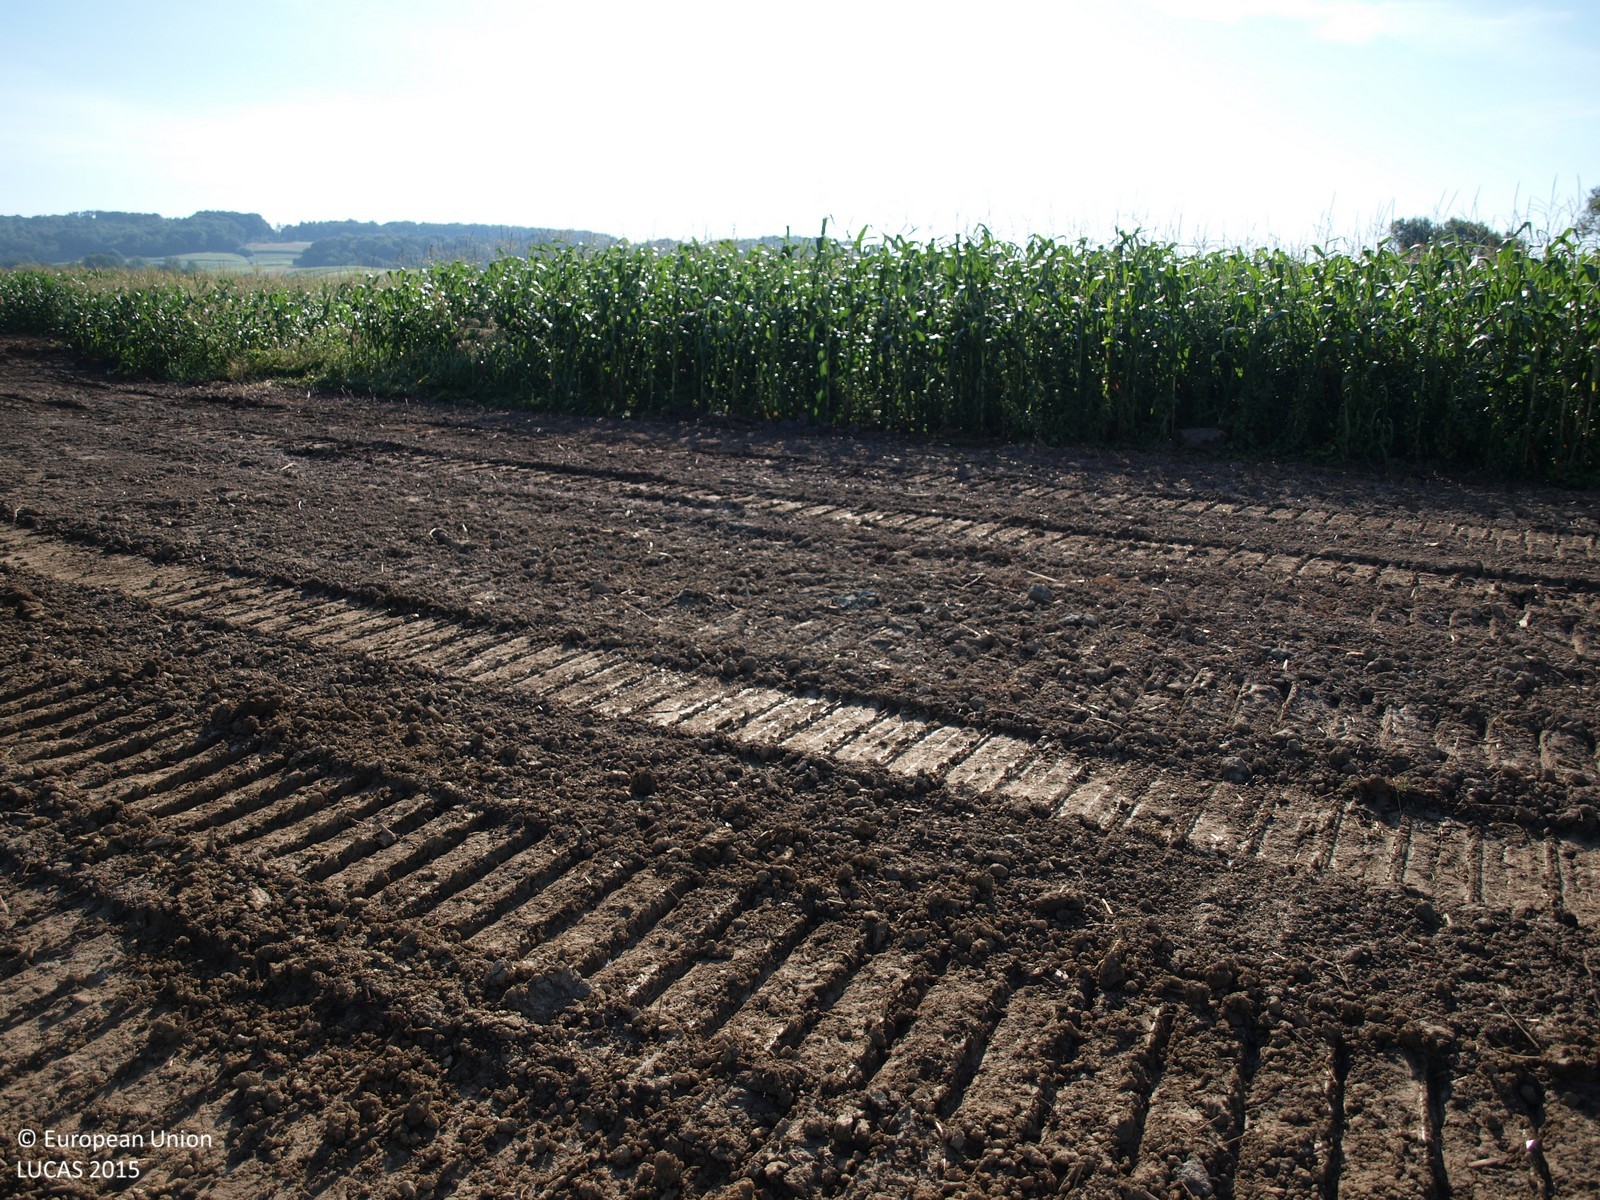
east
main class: Shrubland
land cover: Shrubland with sparse tree cover
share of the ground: > 75 %
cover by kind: shrubs 95 %, broadleaved forest trees 5 %
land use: Semi-natural and natural areas not in use
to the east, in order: Shrubland with sparse tree cover; Rivers and streams; Other bare soil; Maize; Tracks; Maize
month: August
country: HR
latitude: 46.0395
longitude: 16.2921
